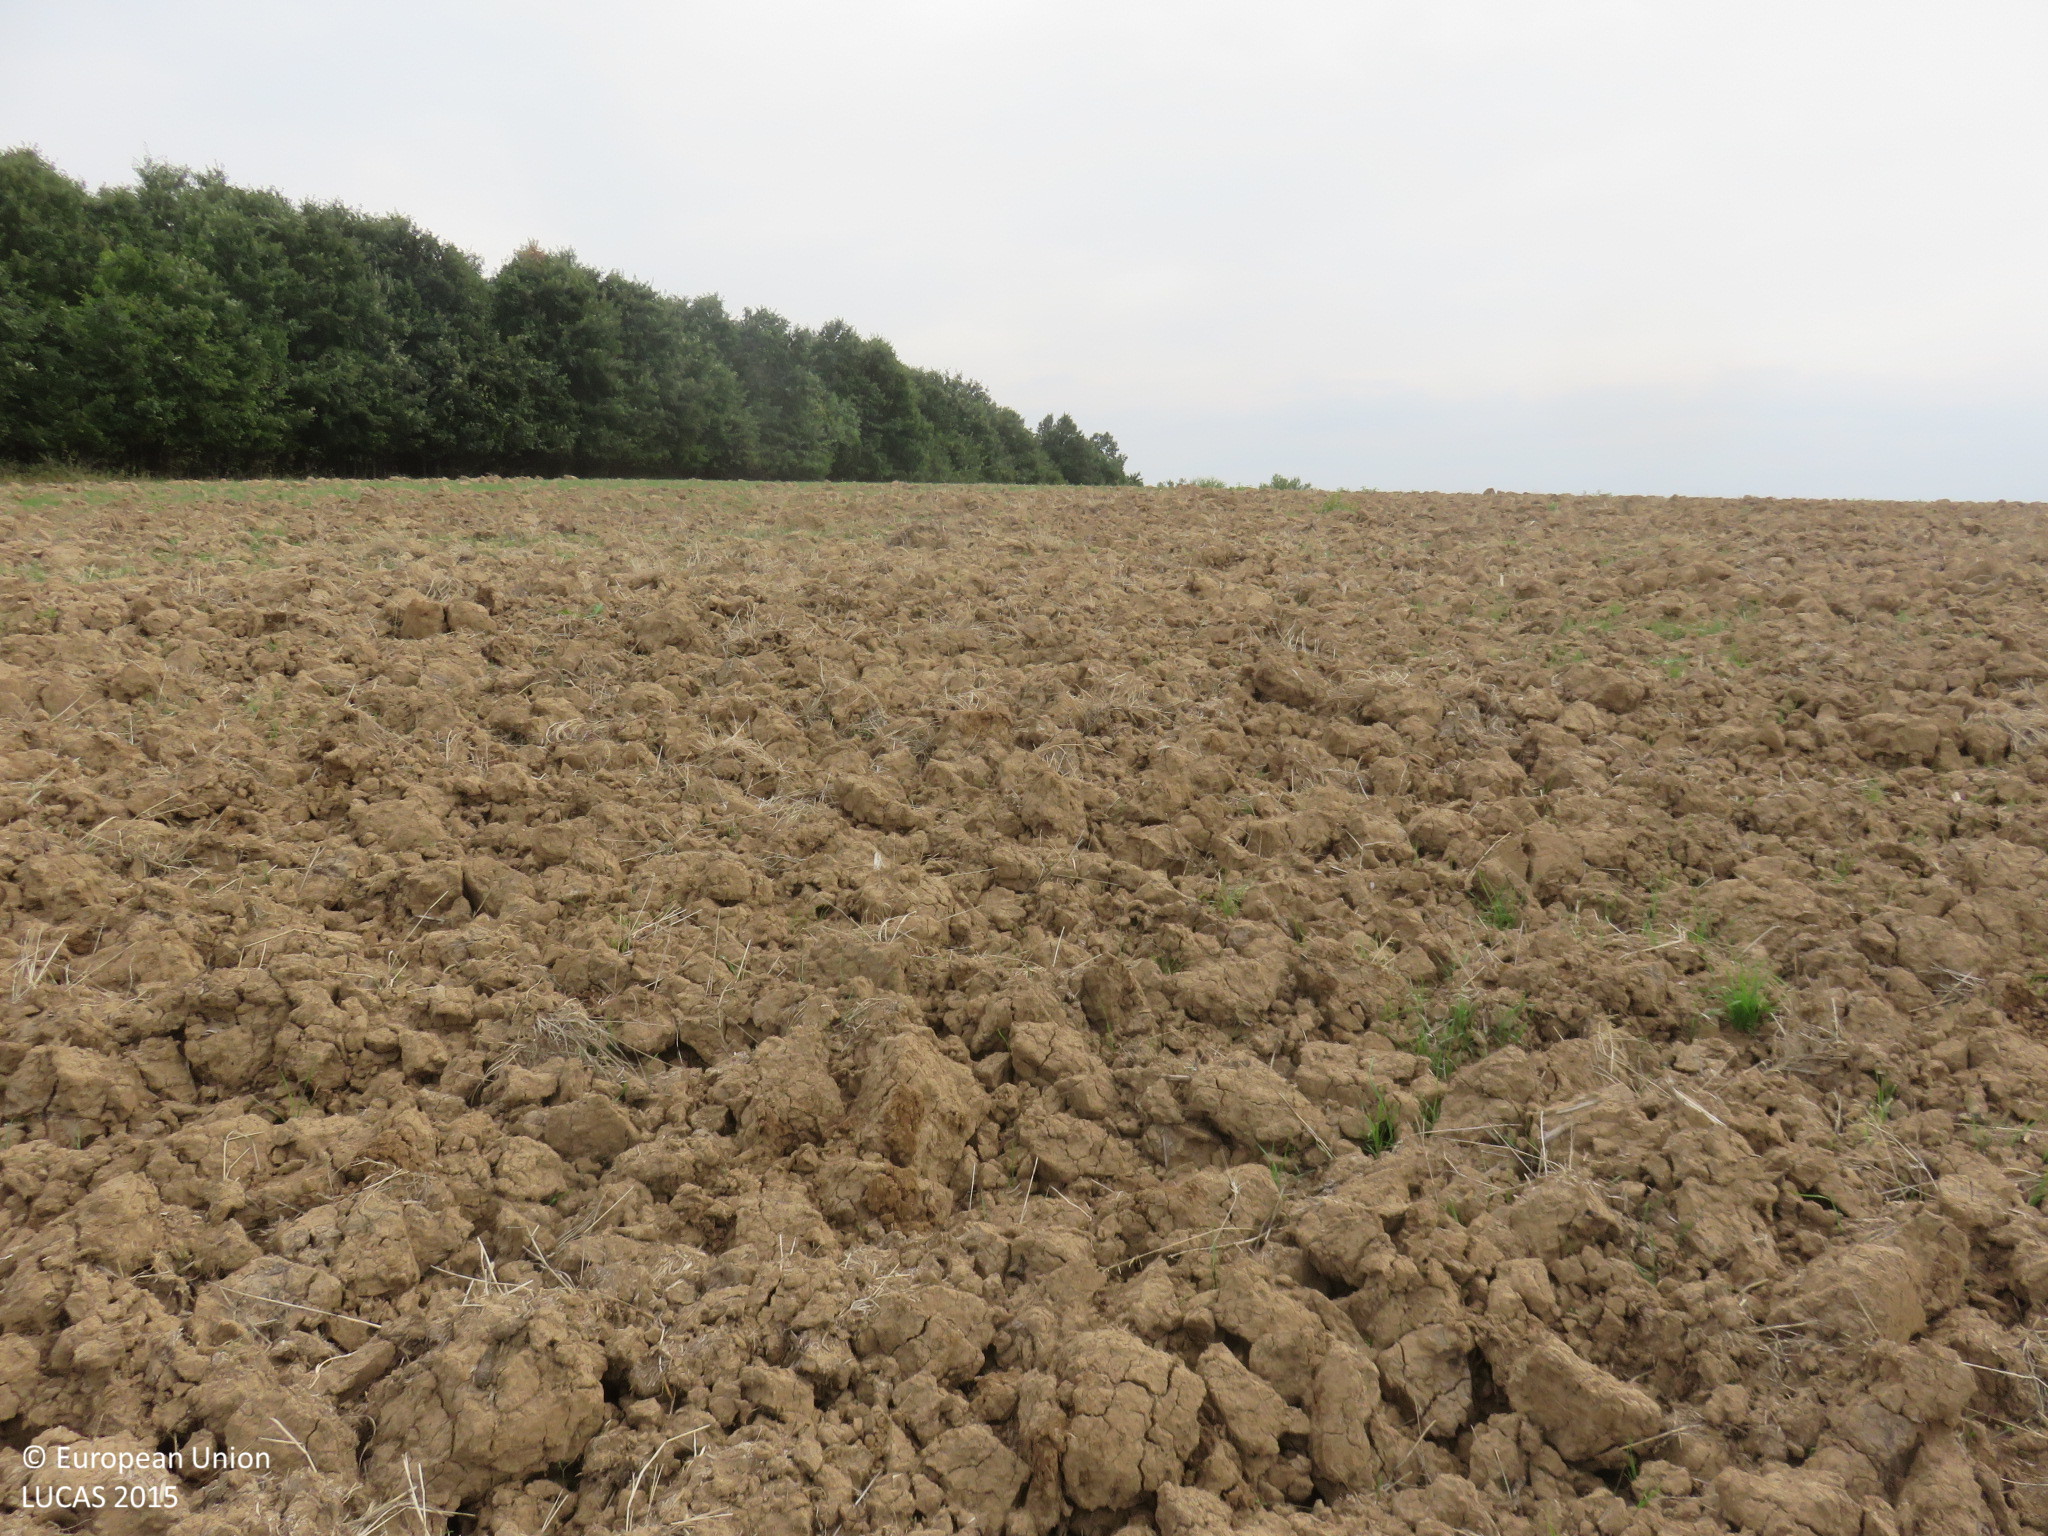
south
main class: Cropland
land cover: Common wheat
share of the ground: < 10 %
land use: Agriculture (excluding fallow land and kitchen gardens)
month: September
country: BG
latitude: 43.1635
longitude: 24.8611
